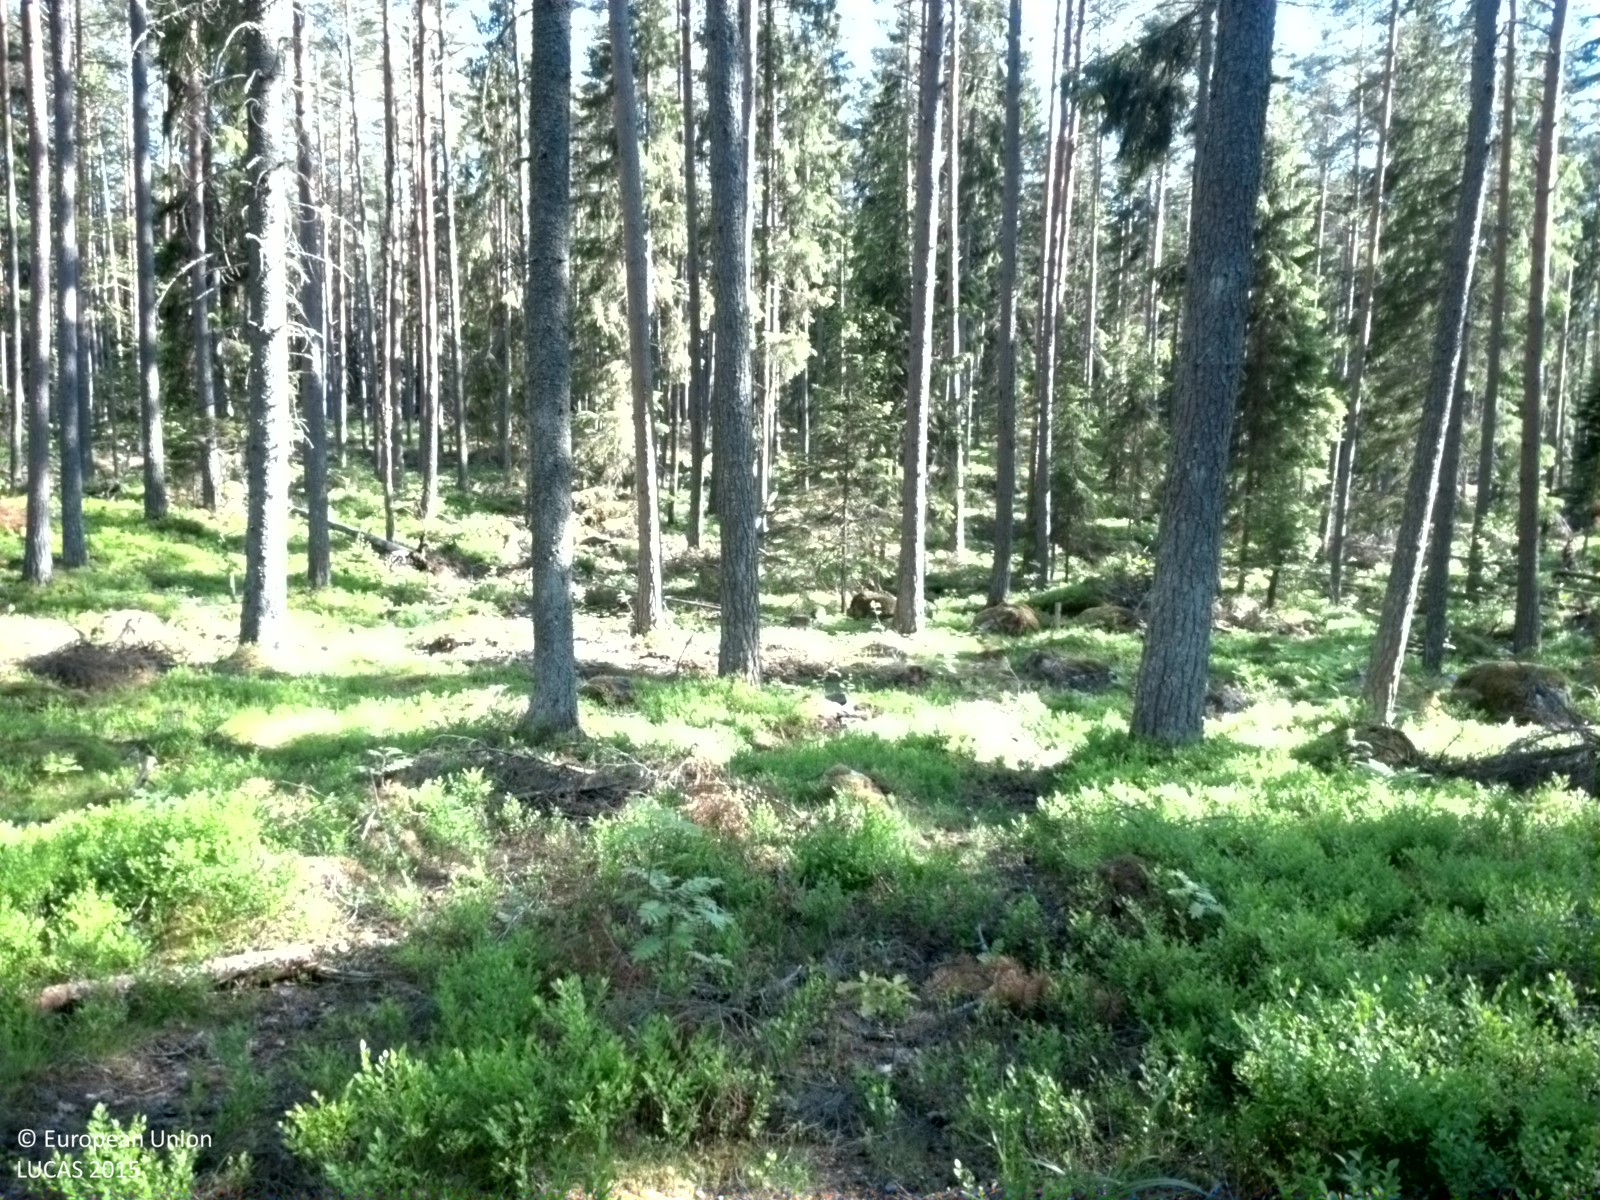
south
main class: Woodland
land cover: Pine dominated coniferous woodland
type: boreal forest
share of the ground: 50 - 75 %
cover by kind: coniferous forest trees 50 %, shrubs 20 %, consolidated bare surface 10 %, herbaceous plants 5 %, lichens and mosses 5 %
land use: Forestry
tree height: > 5 m
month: June
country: SE
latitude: 60.1699
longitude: 17.6888
